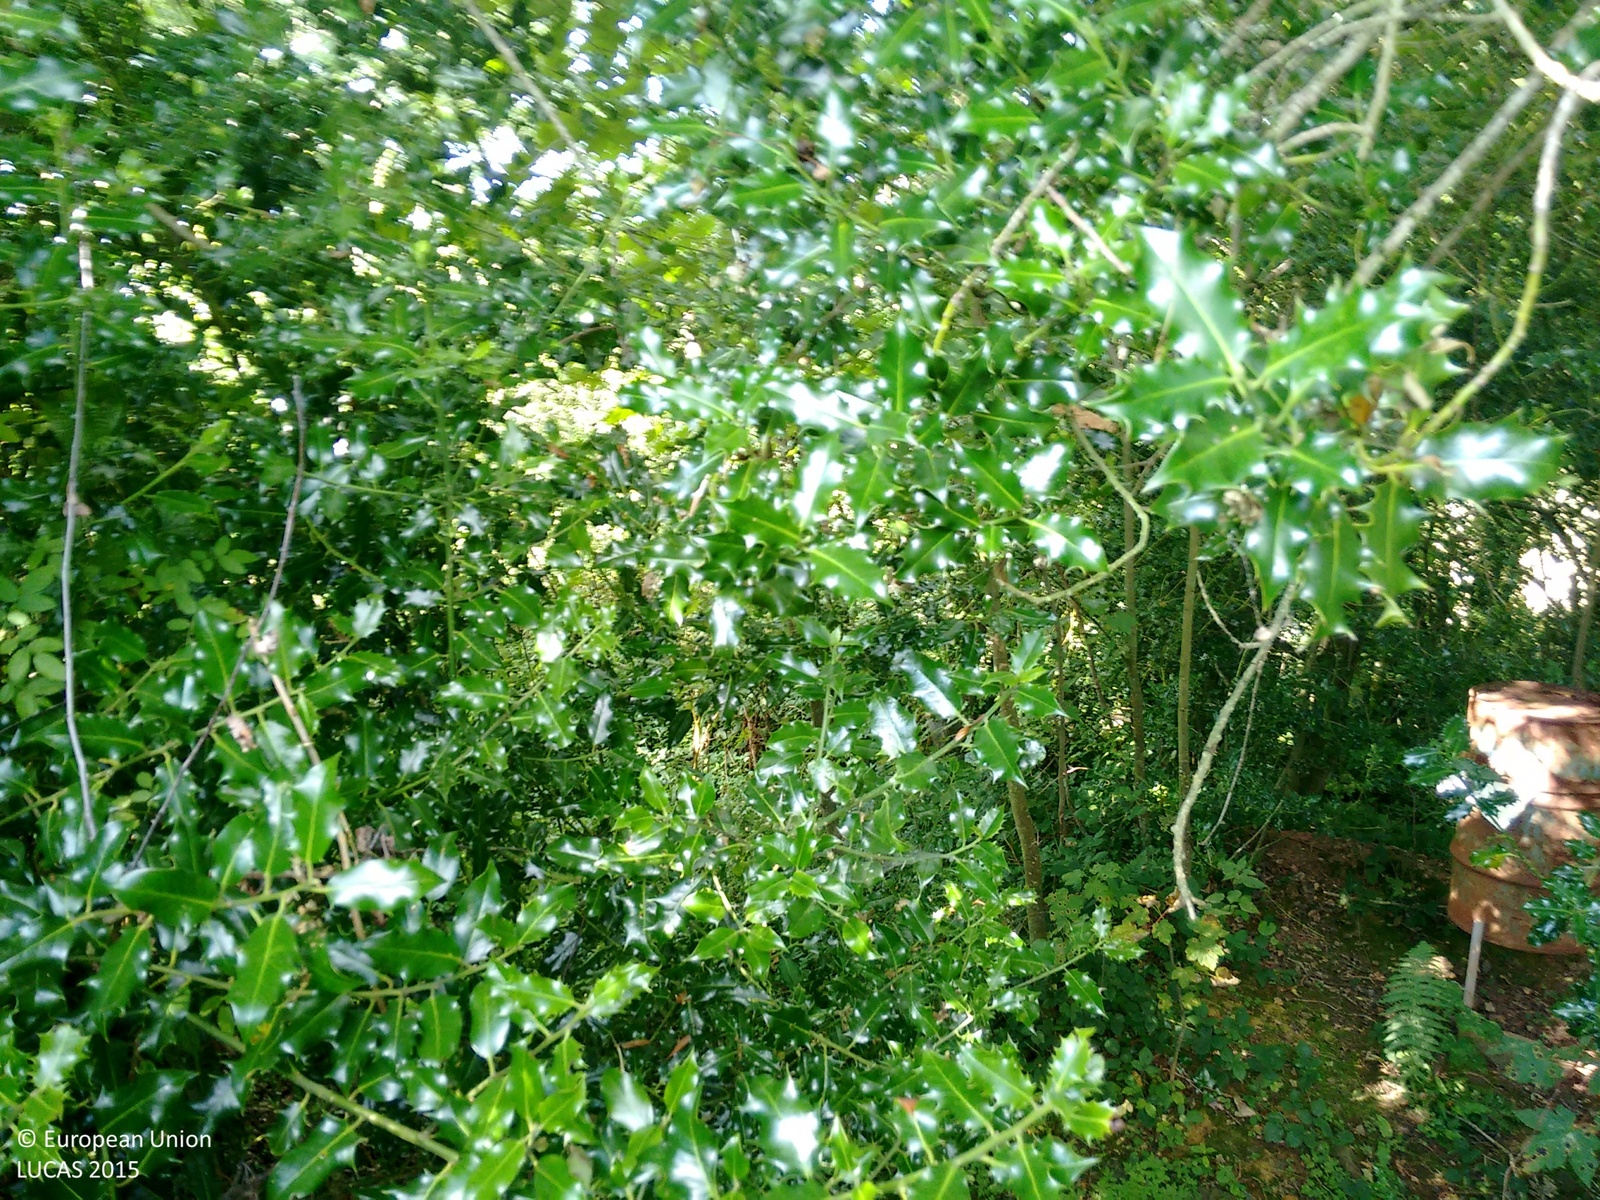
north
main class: Woodland
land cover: Broadleaved woodland
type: acidophilous oak and oak-birch forest
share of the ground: > 75 %
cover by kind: broadleaved forest trees 100 %
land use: Semi-natural and natural areas not in use
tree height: > 5 m
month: September
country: GB
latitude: 50.9897
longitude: -4.1880
